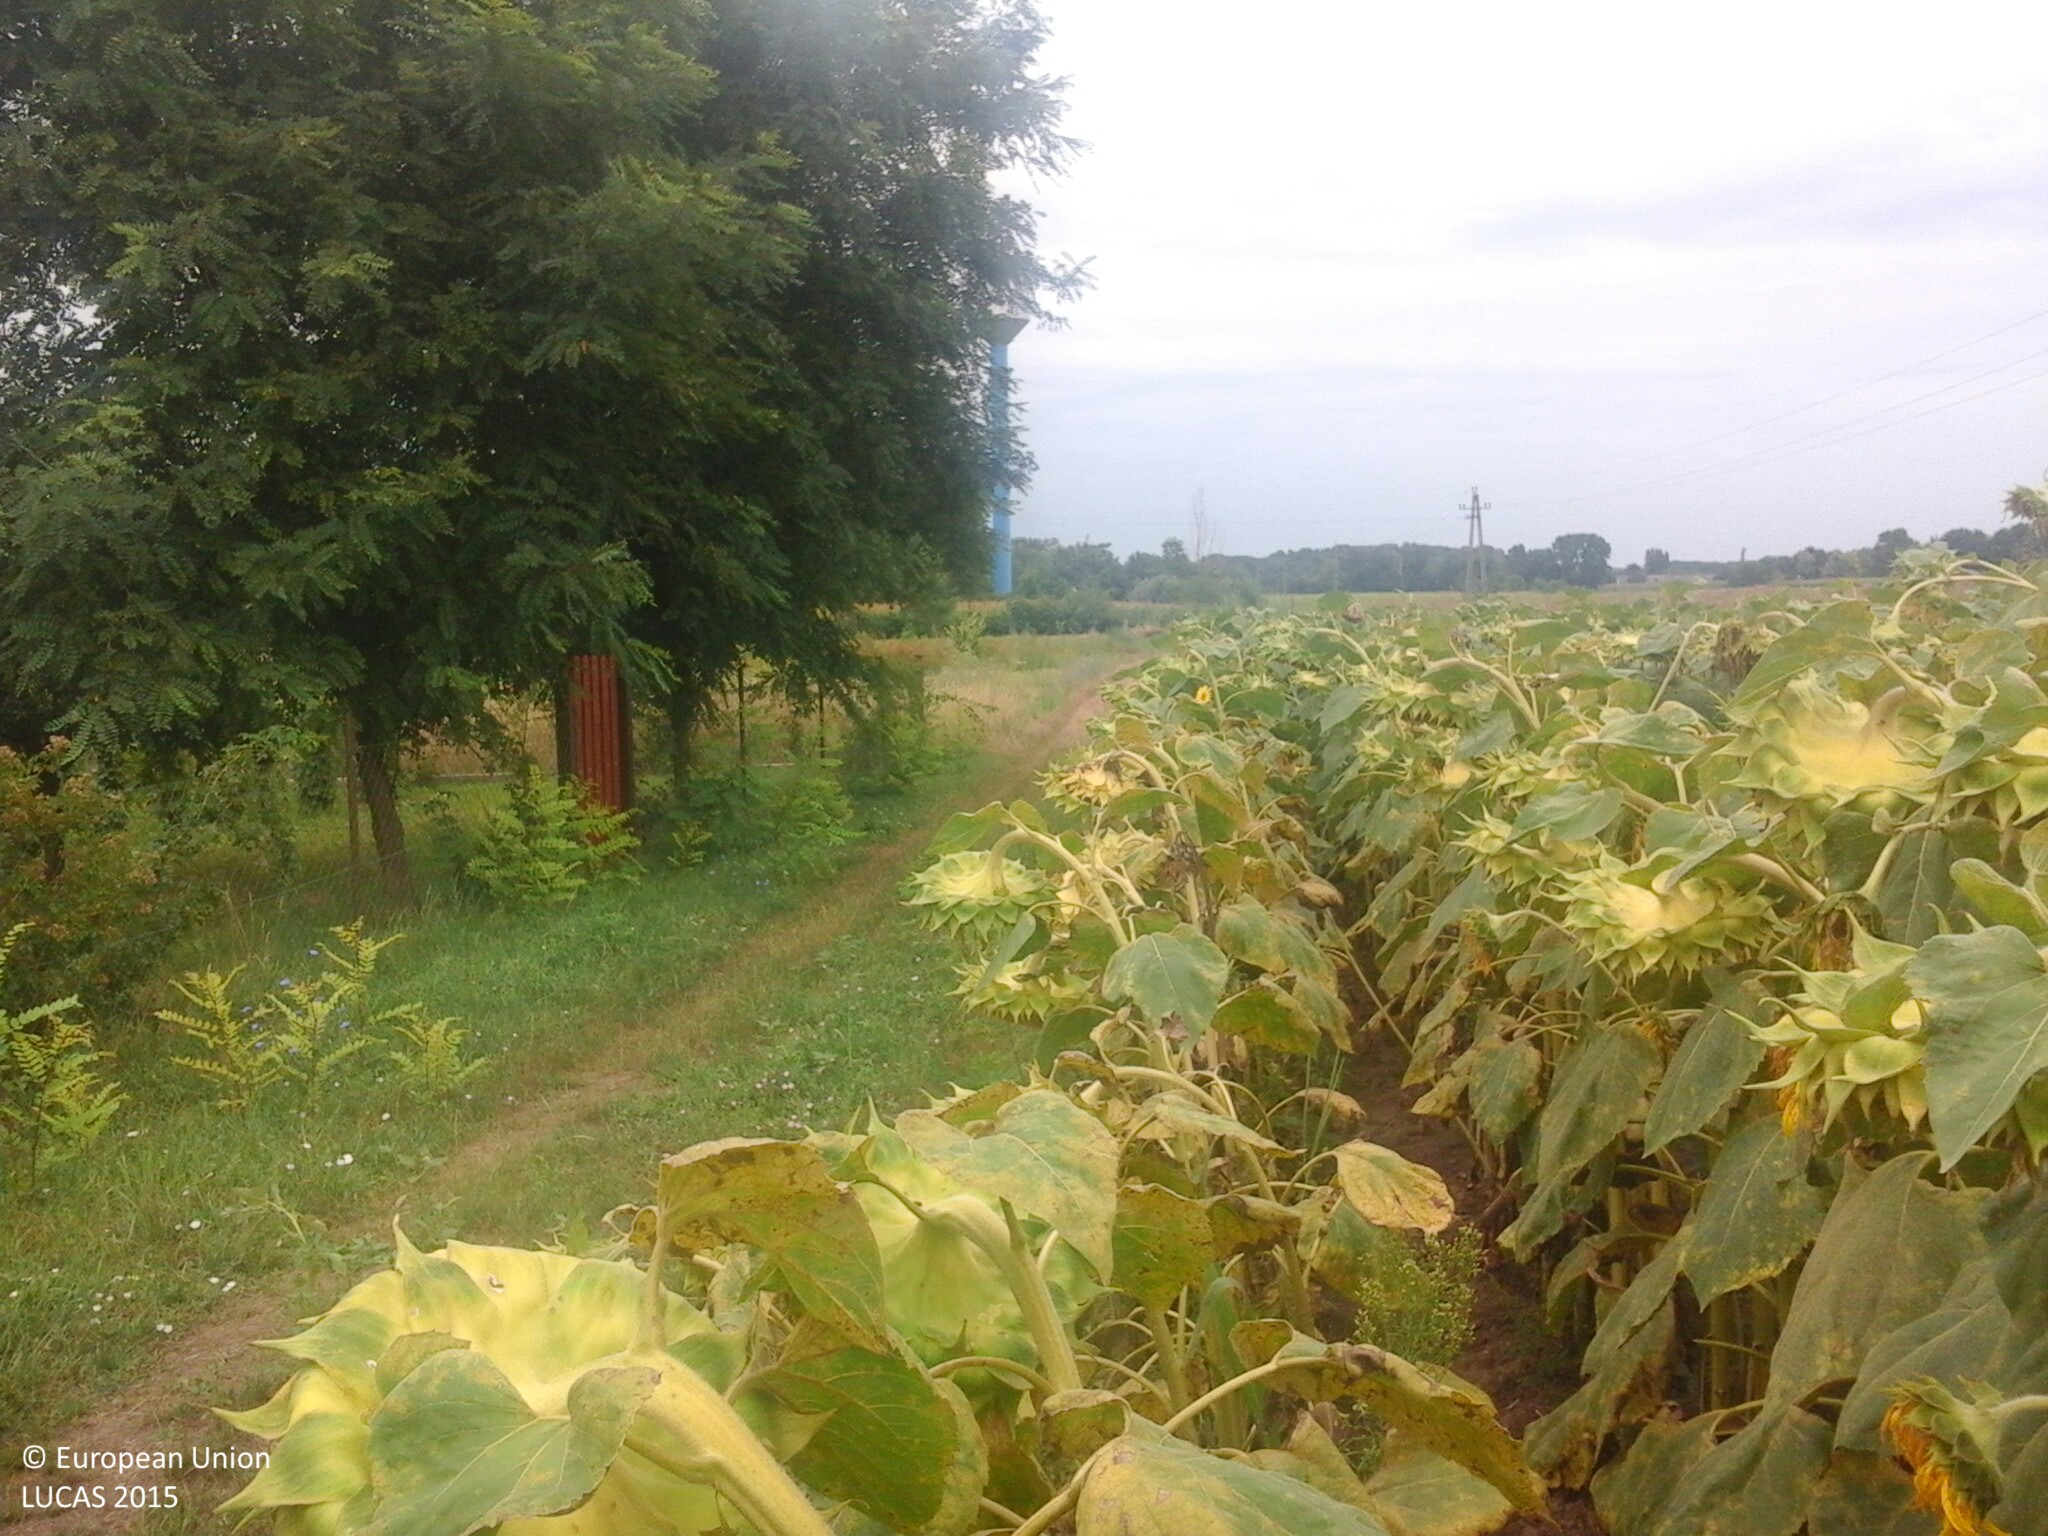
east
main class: Cropland
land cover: Sunflower
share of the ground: > 75 %
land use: Agriculture (excluding fallow land and kitchen gardens)
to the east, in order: Sunflower; Electric lines; Sunflower; Tracks; Grass margins; Other fresh vegetables; Artificial constructions in urban areas
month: July
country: HU
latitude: 47.0125
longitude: 18.4437
